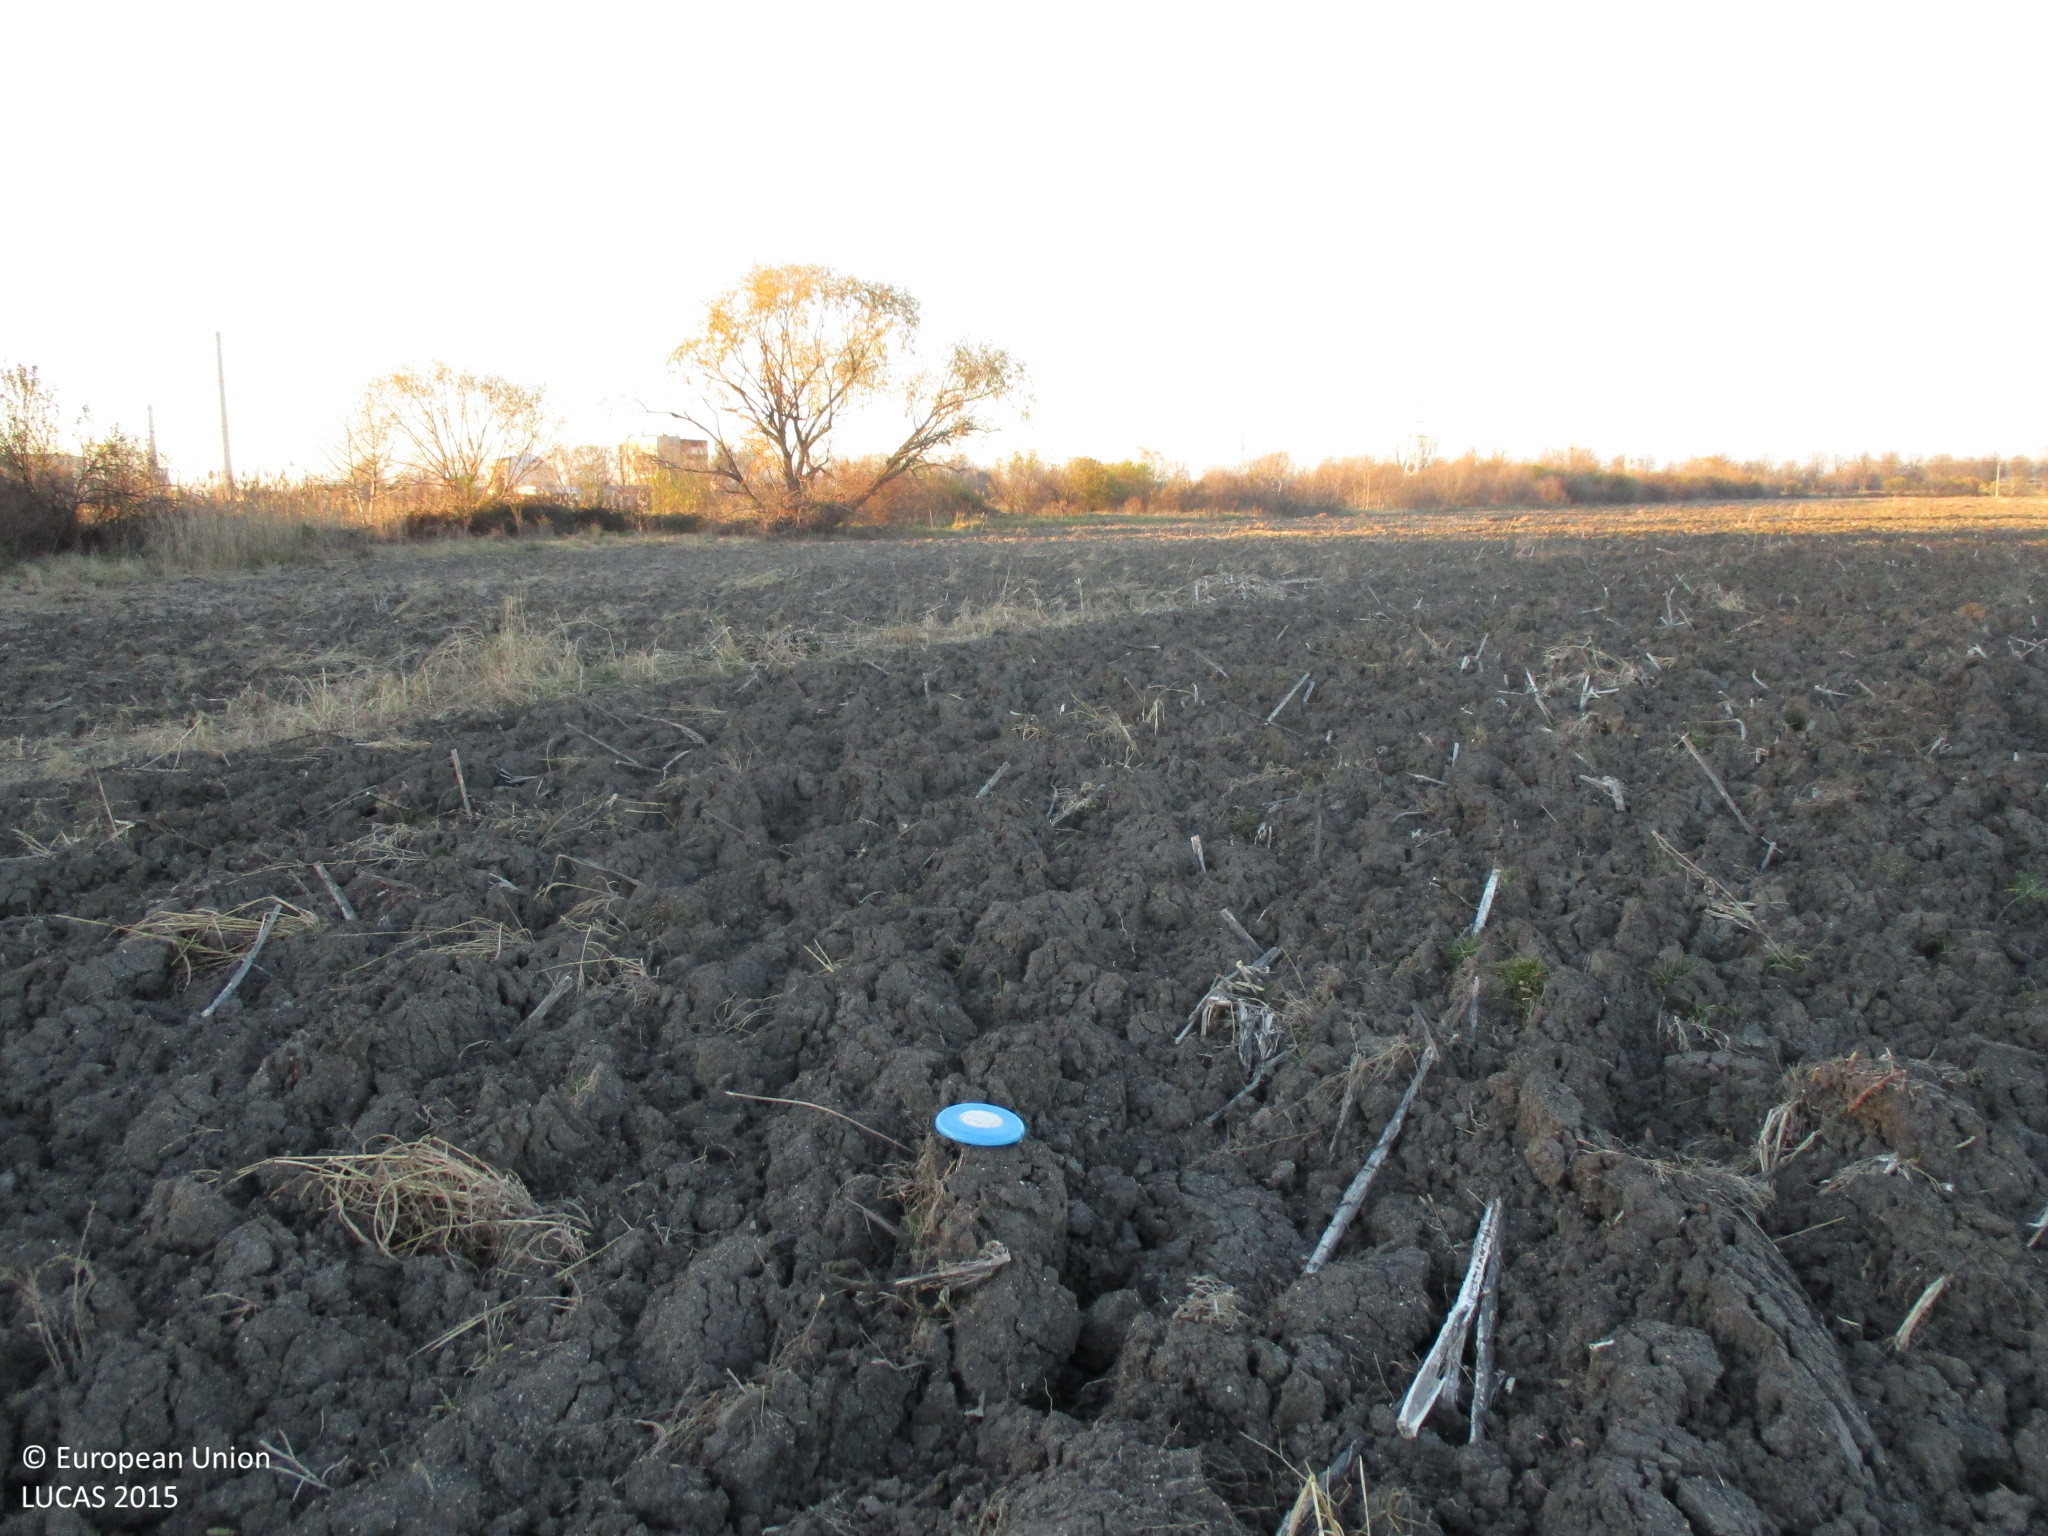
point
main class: Cropland
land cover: Sunflower
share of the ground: < 10 %
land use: Agriculture (excluding fallow land and kitchen gardens)
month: December
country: BG
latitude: 42.1707
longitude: 24.7598
